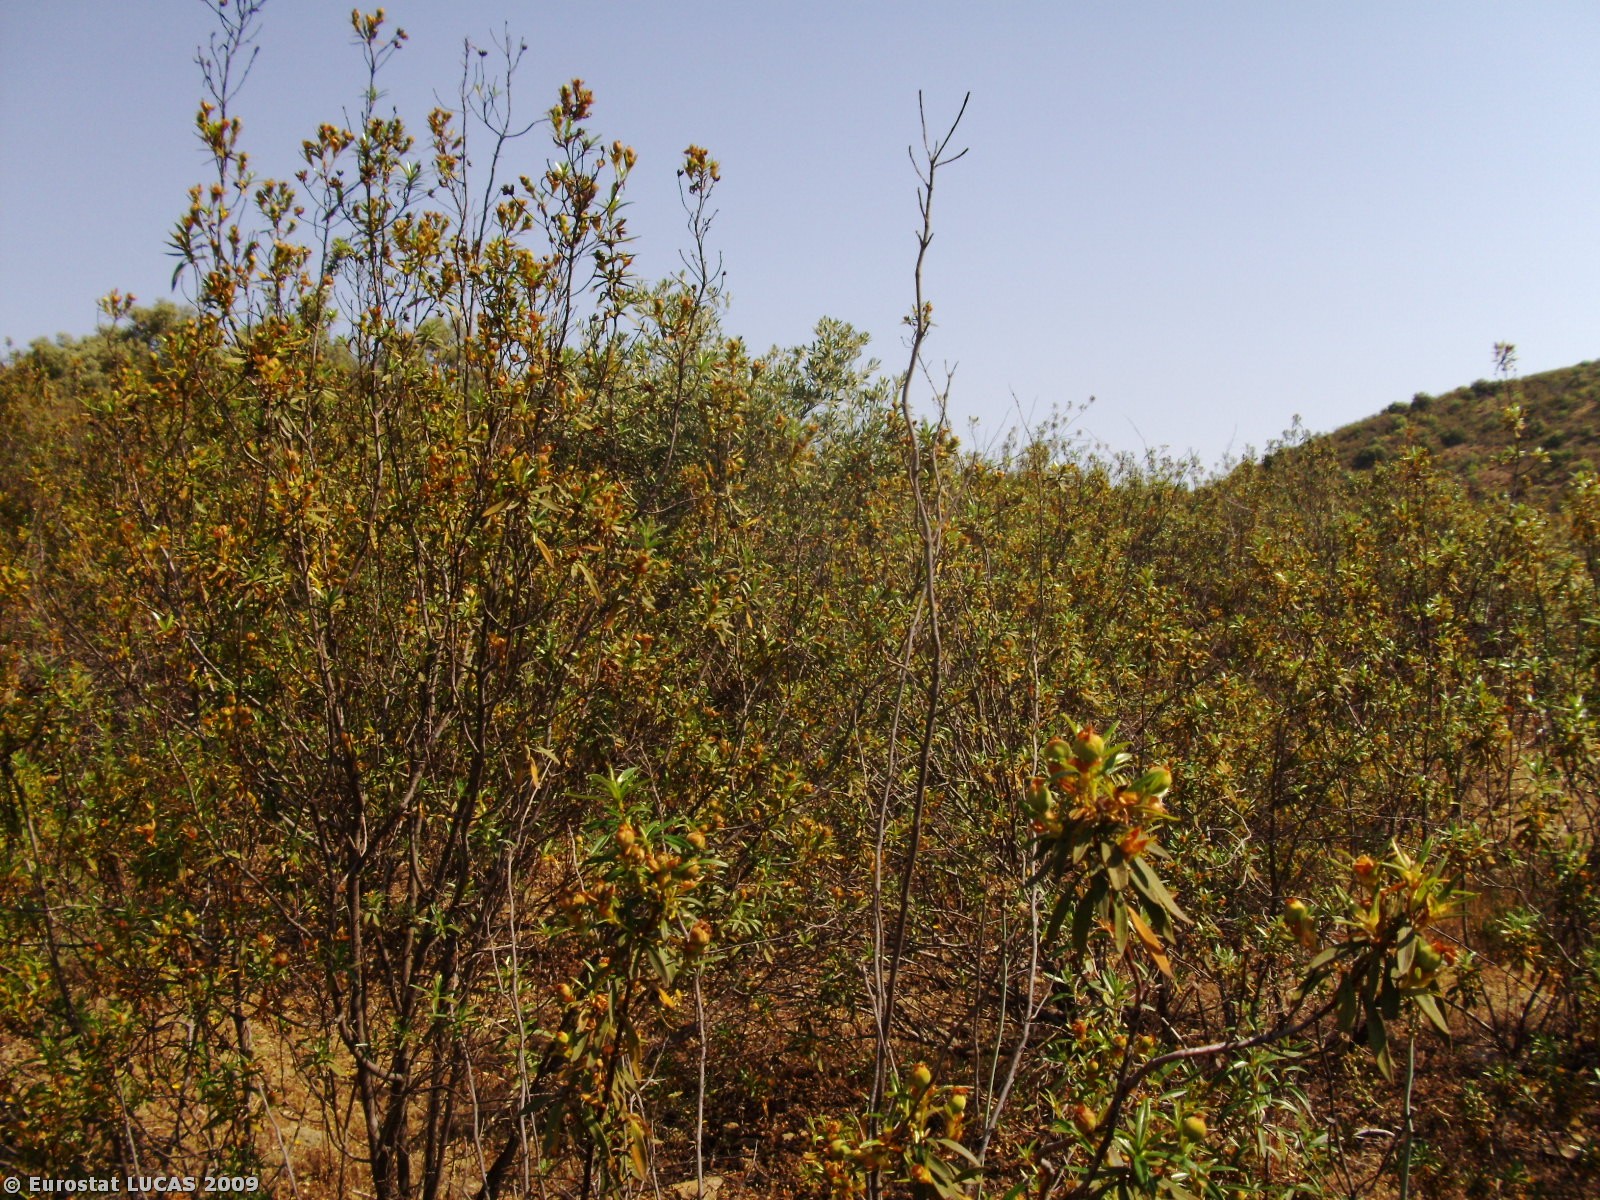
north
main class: Shrubland
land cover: Shrubland with sparse tree cover
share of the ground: > 75 %
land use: Fallow land
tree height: > 5 m
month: May
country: PT
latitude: 37.5072
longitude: -7.6490
